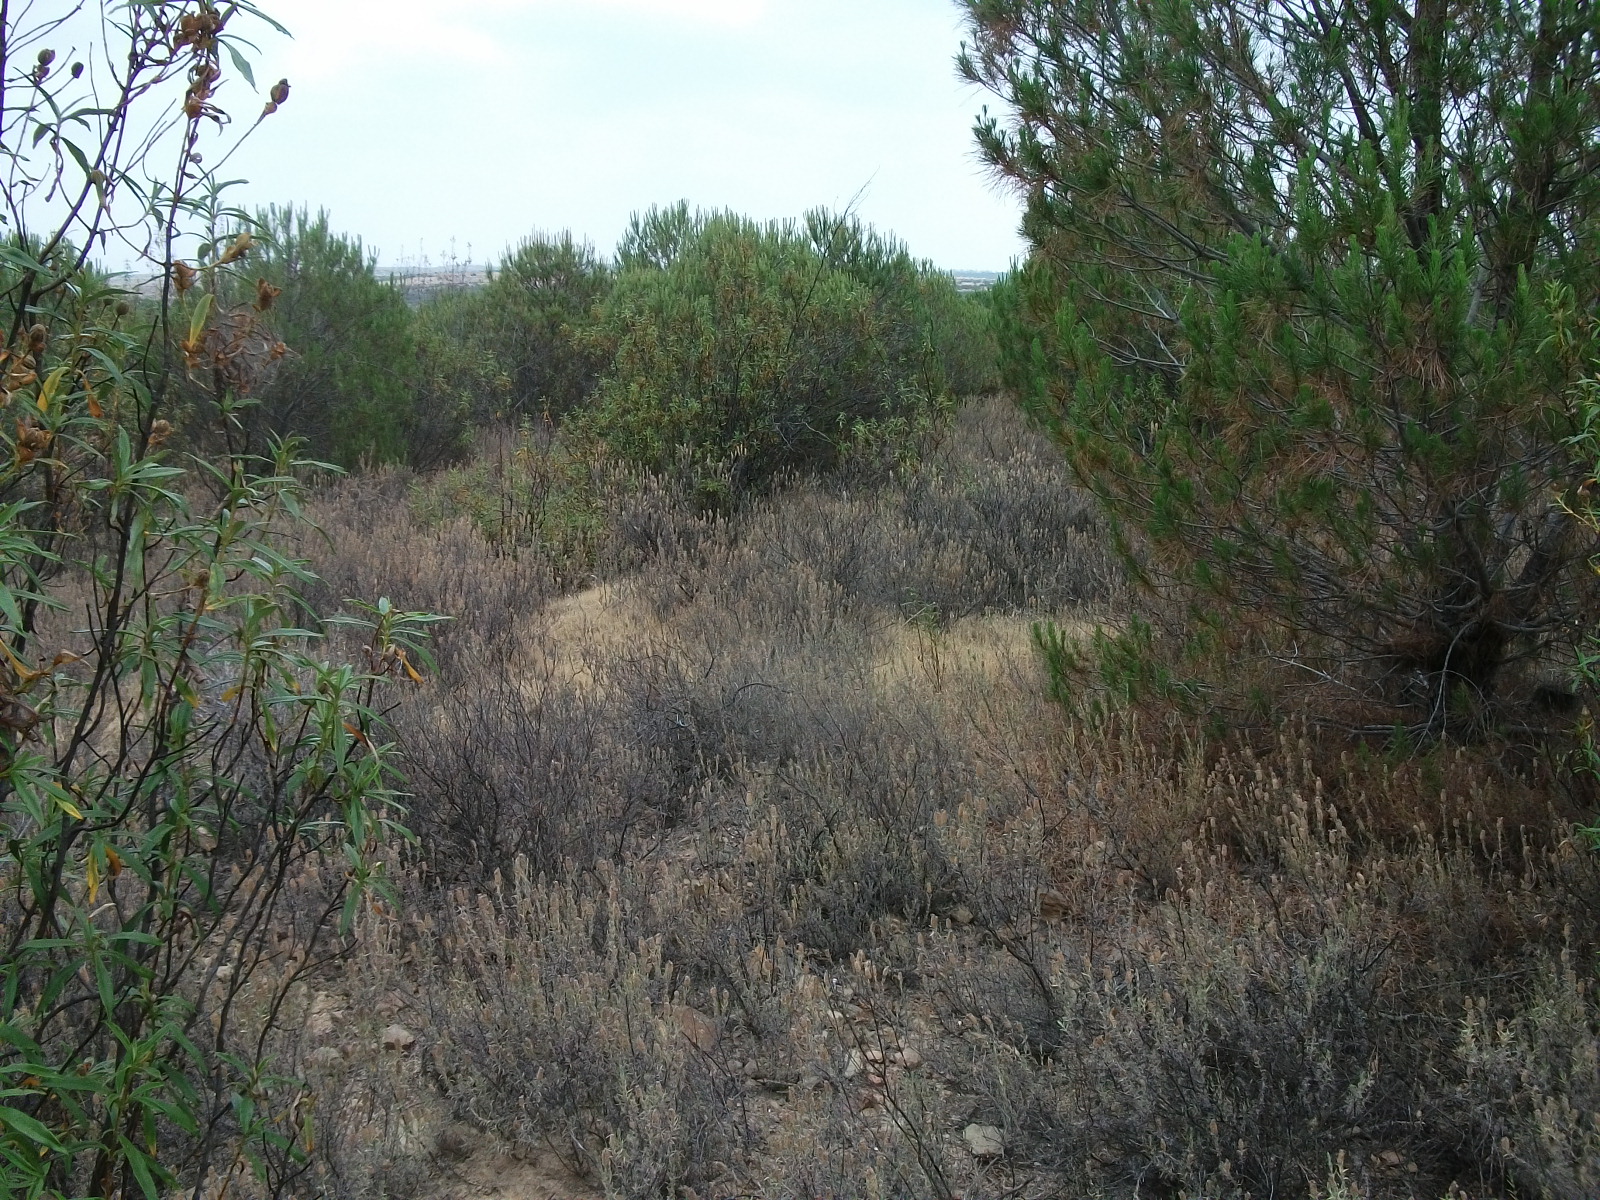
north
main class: Woodland
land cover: Pine dominated coniferous woodland
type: coniferous forest of the mediterranean region
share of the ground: 50 - 75 %
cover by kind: coniferous forest trees 60 %, shrubs 30 %, herbaceous plants 10 %
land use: Forestry
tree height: < 5 m
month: June
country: ES
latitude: 37.4610
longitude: -6.8981
